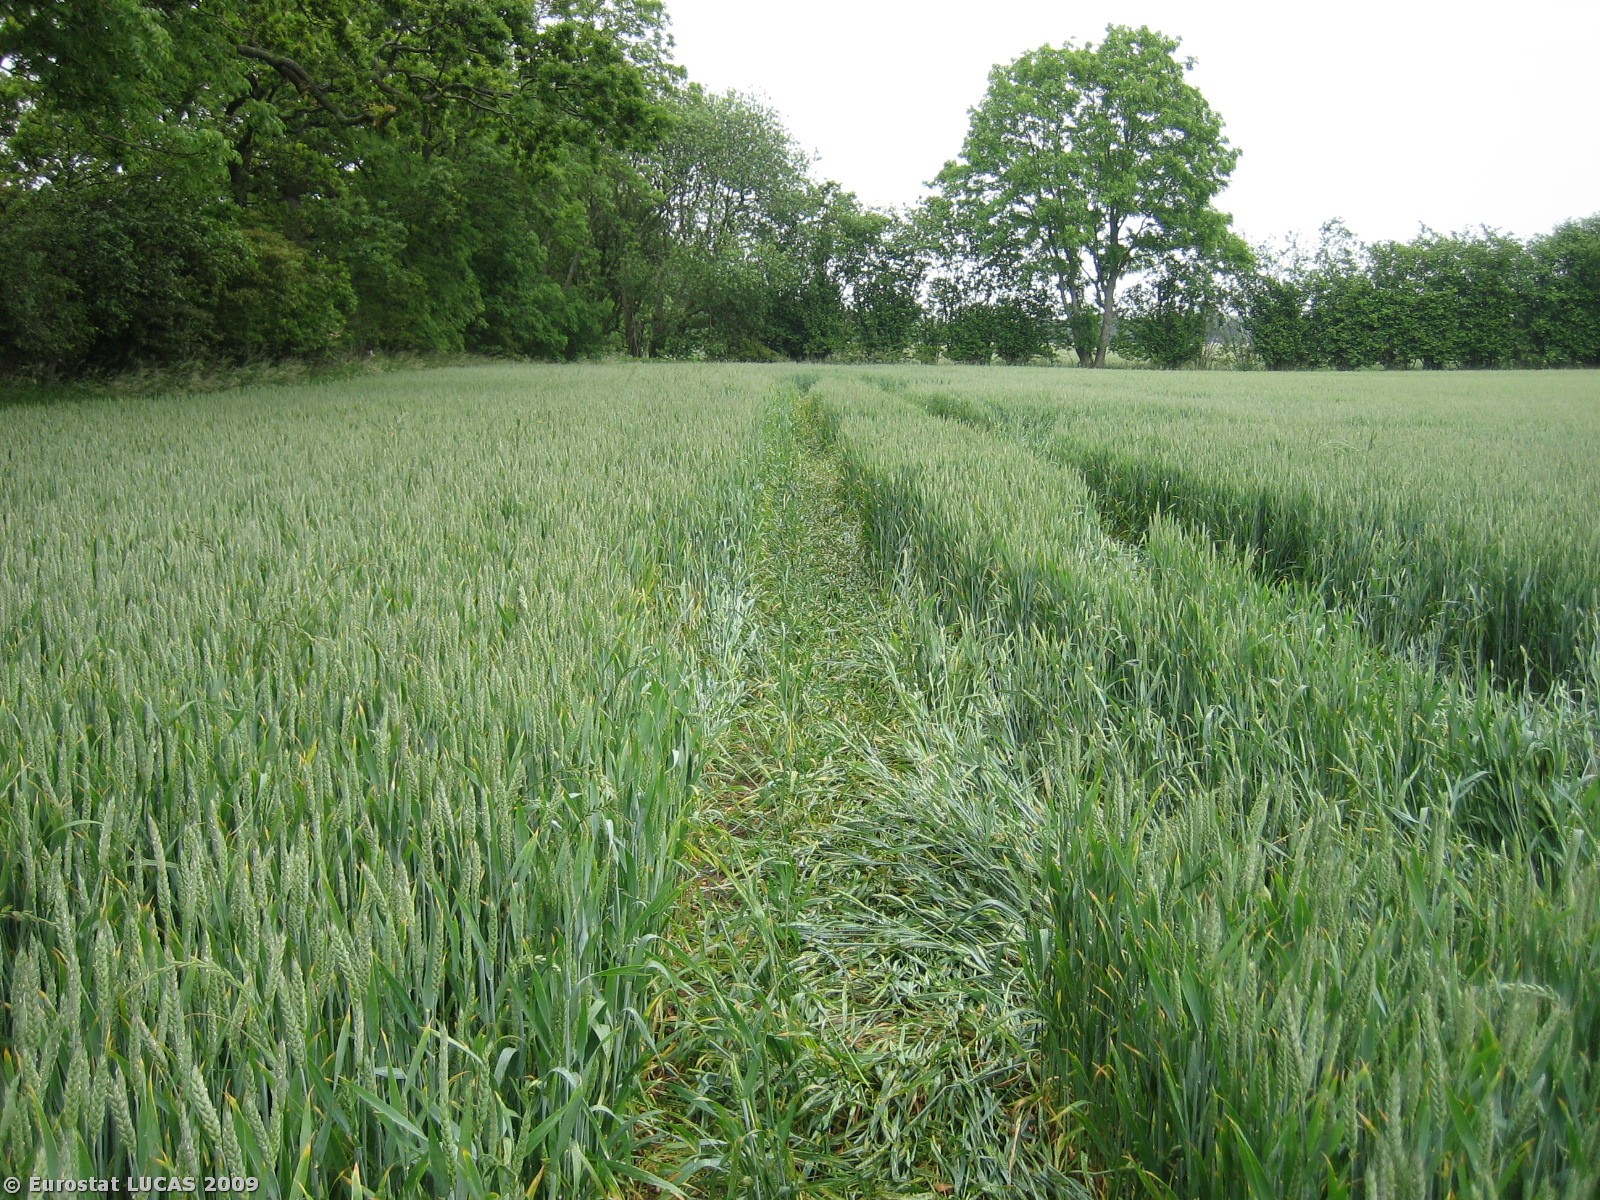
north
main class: Cropland
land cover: Common wheat
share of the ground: > 75 %
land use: Agriculture (excluding fallow land and kitchen gardens)
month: June
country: DK
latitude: 55.8641
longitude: 10.1756
